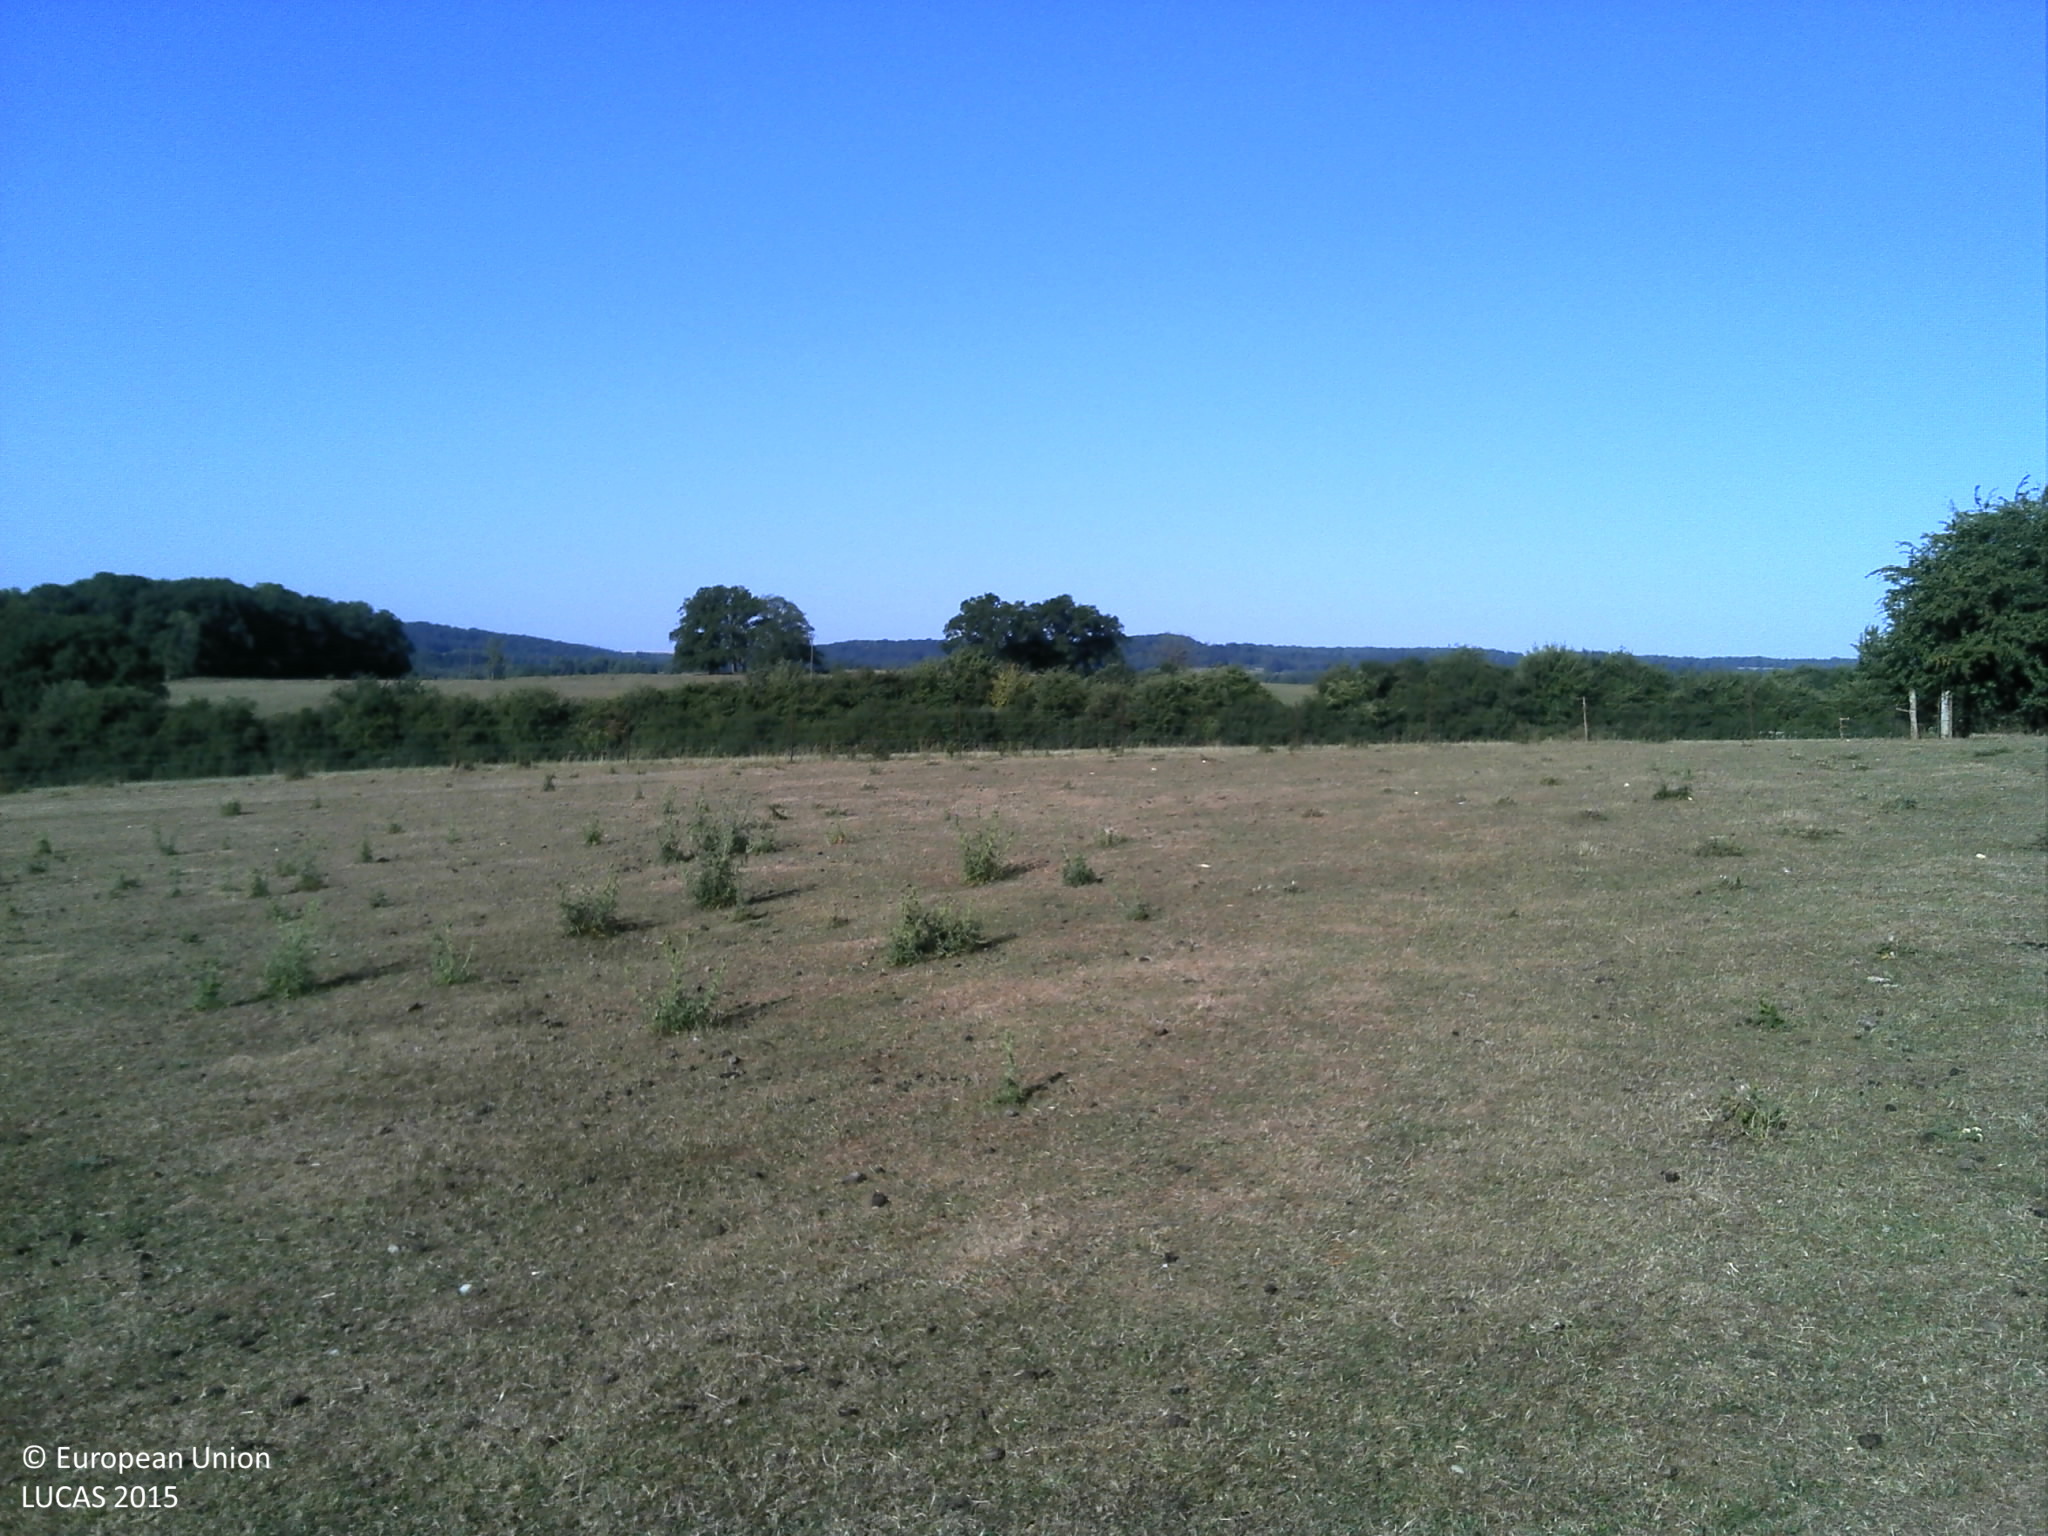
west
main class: Grassland
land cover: Grassland without tree/shrub cover
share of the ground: > 75 %
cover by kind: herbaceous plants 100 %
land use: Agriculture (excluding fallow land and kitchen gardens)
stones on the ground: < 10 %
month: July
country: FR
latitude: 49.6295
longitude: 4.7220
